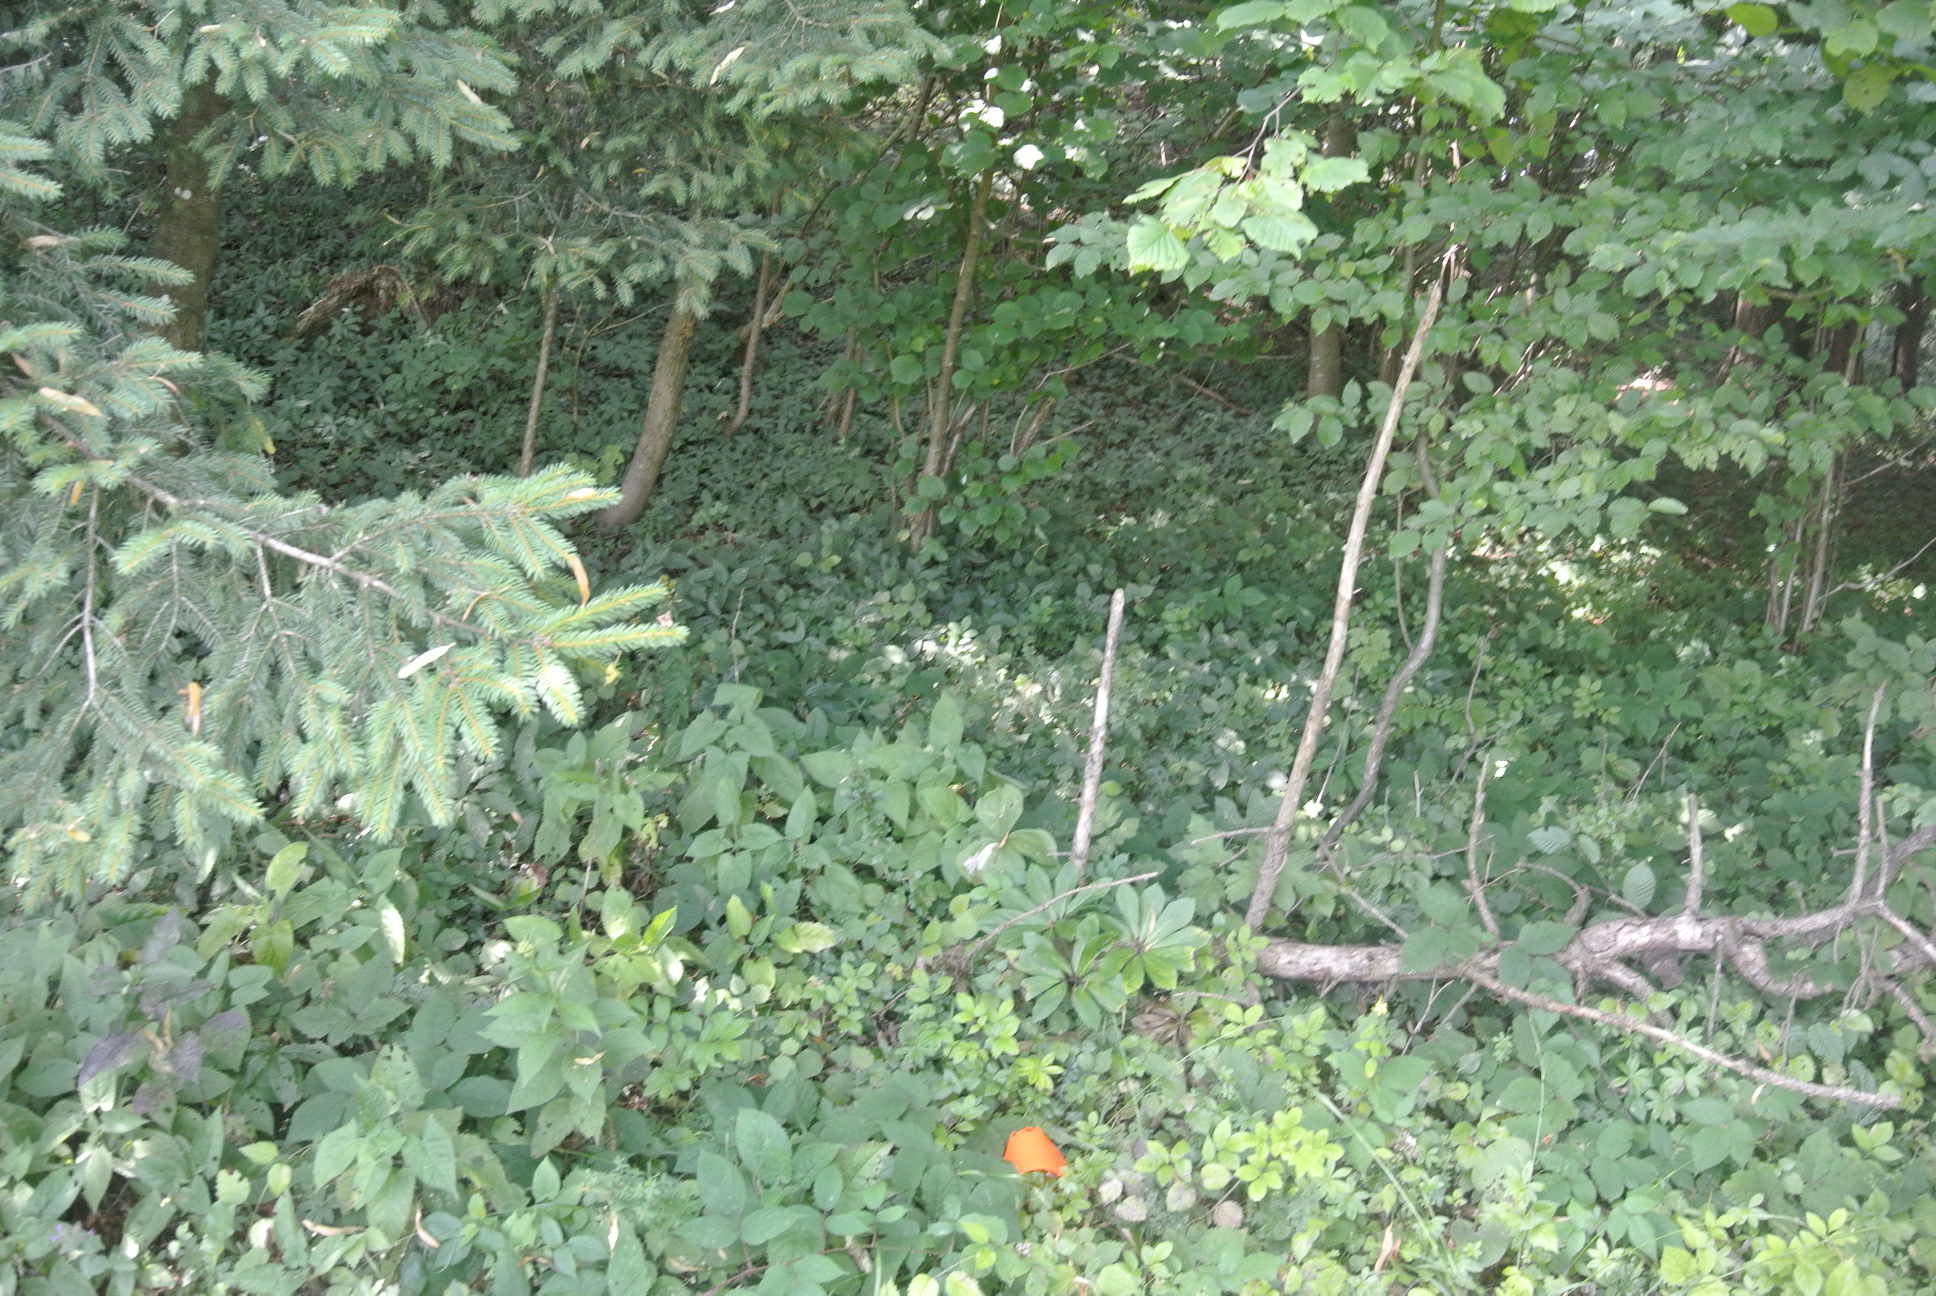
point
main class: Woodland
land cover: Spruce dominated mixed woodland
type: alpine coniferous forest
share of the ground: > 75 %
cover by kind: coniferous forest trees 60 %, broadleaved forest trees 40 %
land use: Forestry
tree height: > 5 m
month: July
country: AT
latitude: 48.0162
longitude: 15.4584
